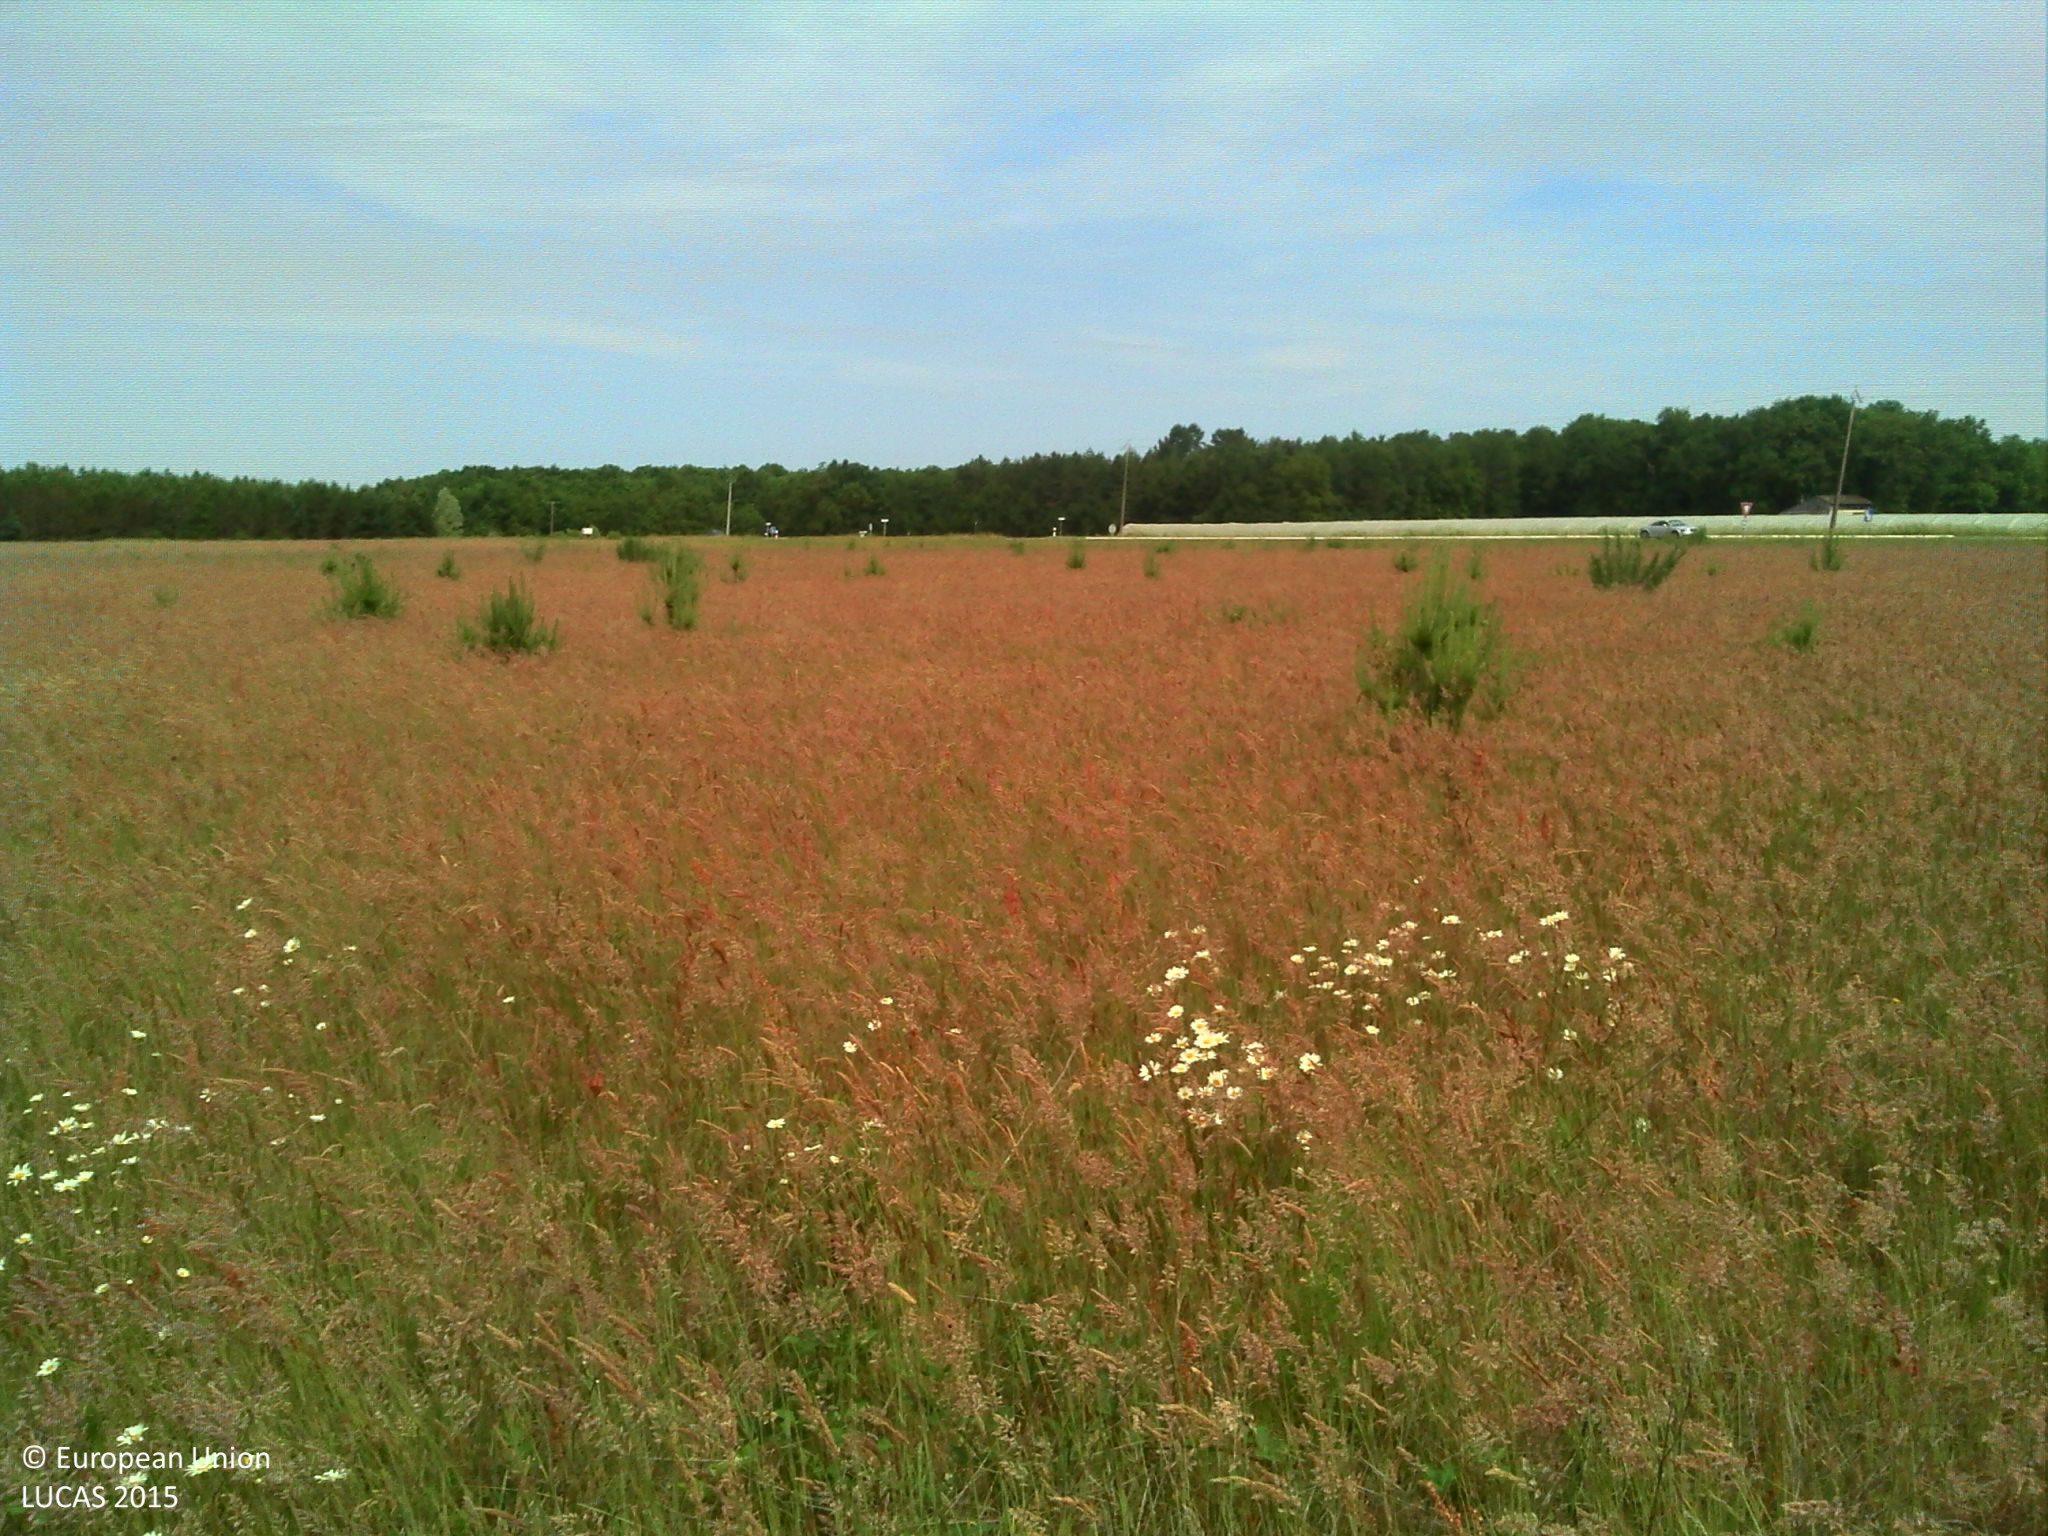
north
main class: Grassland
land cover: Grassland without tree/shrub cover
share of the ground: > 75 %
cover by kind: herbaceous plants 95 %, shrubs 5 %
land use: Agriculture (excluding fallow land and kitchen gardens)
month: June
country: FR
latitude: 47.4455
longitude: 1.5390
